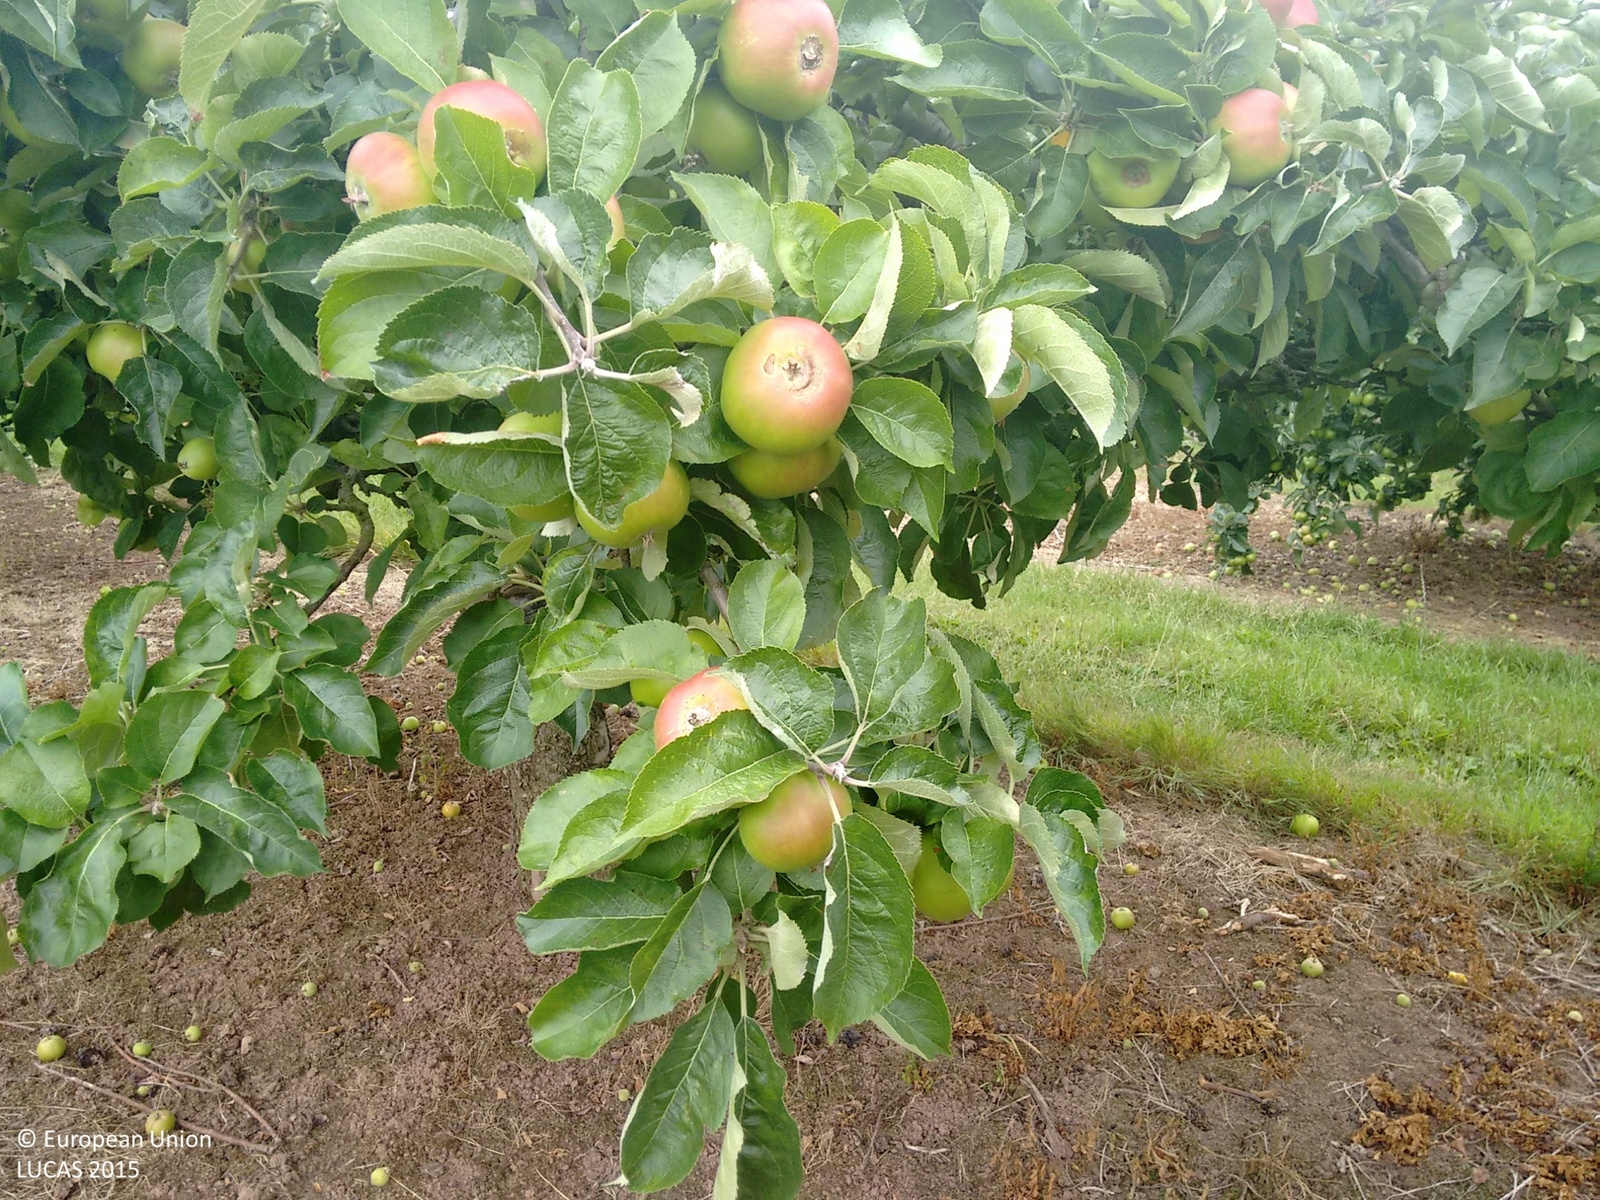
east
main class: Cropland
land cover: Apple fruit
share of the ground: > 75 %
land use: Agriculture (excluding fallow land and kitchen gardens)
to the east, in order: Apple fruit; Grassland without tree/shrub cover; Abandoned hedges; Fences; Grassland without tree/shrub cover; Electric lines; Grassland without tree/shrub cover
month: August
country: GB
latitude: 51.9631
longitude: -2.7174
